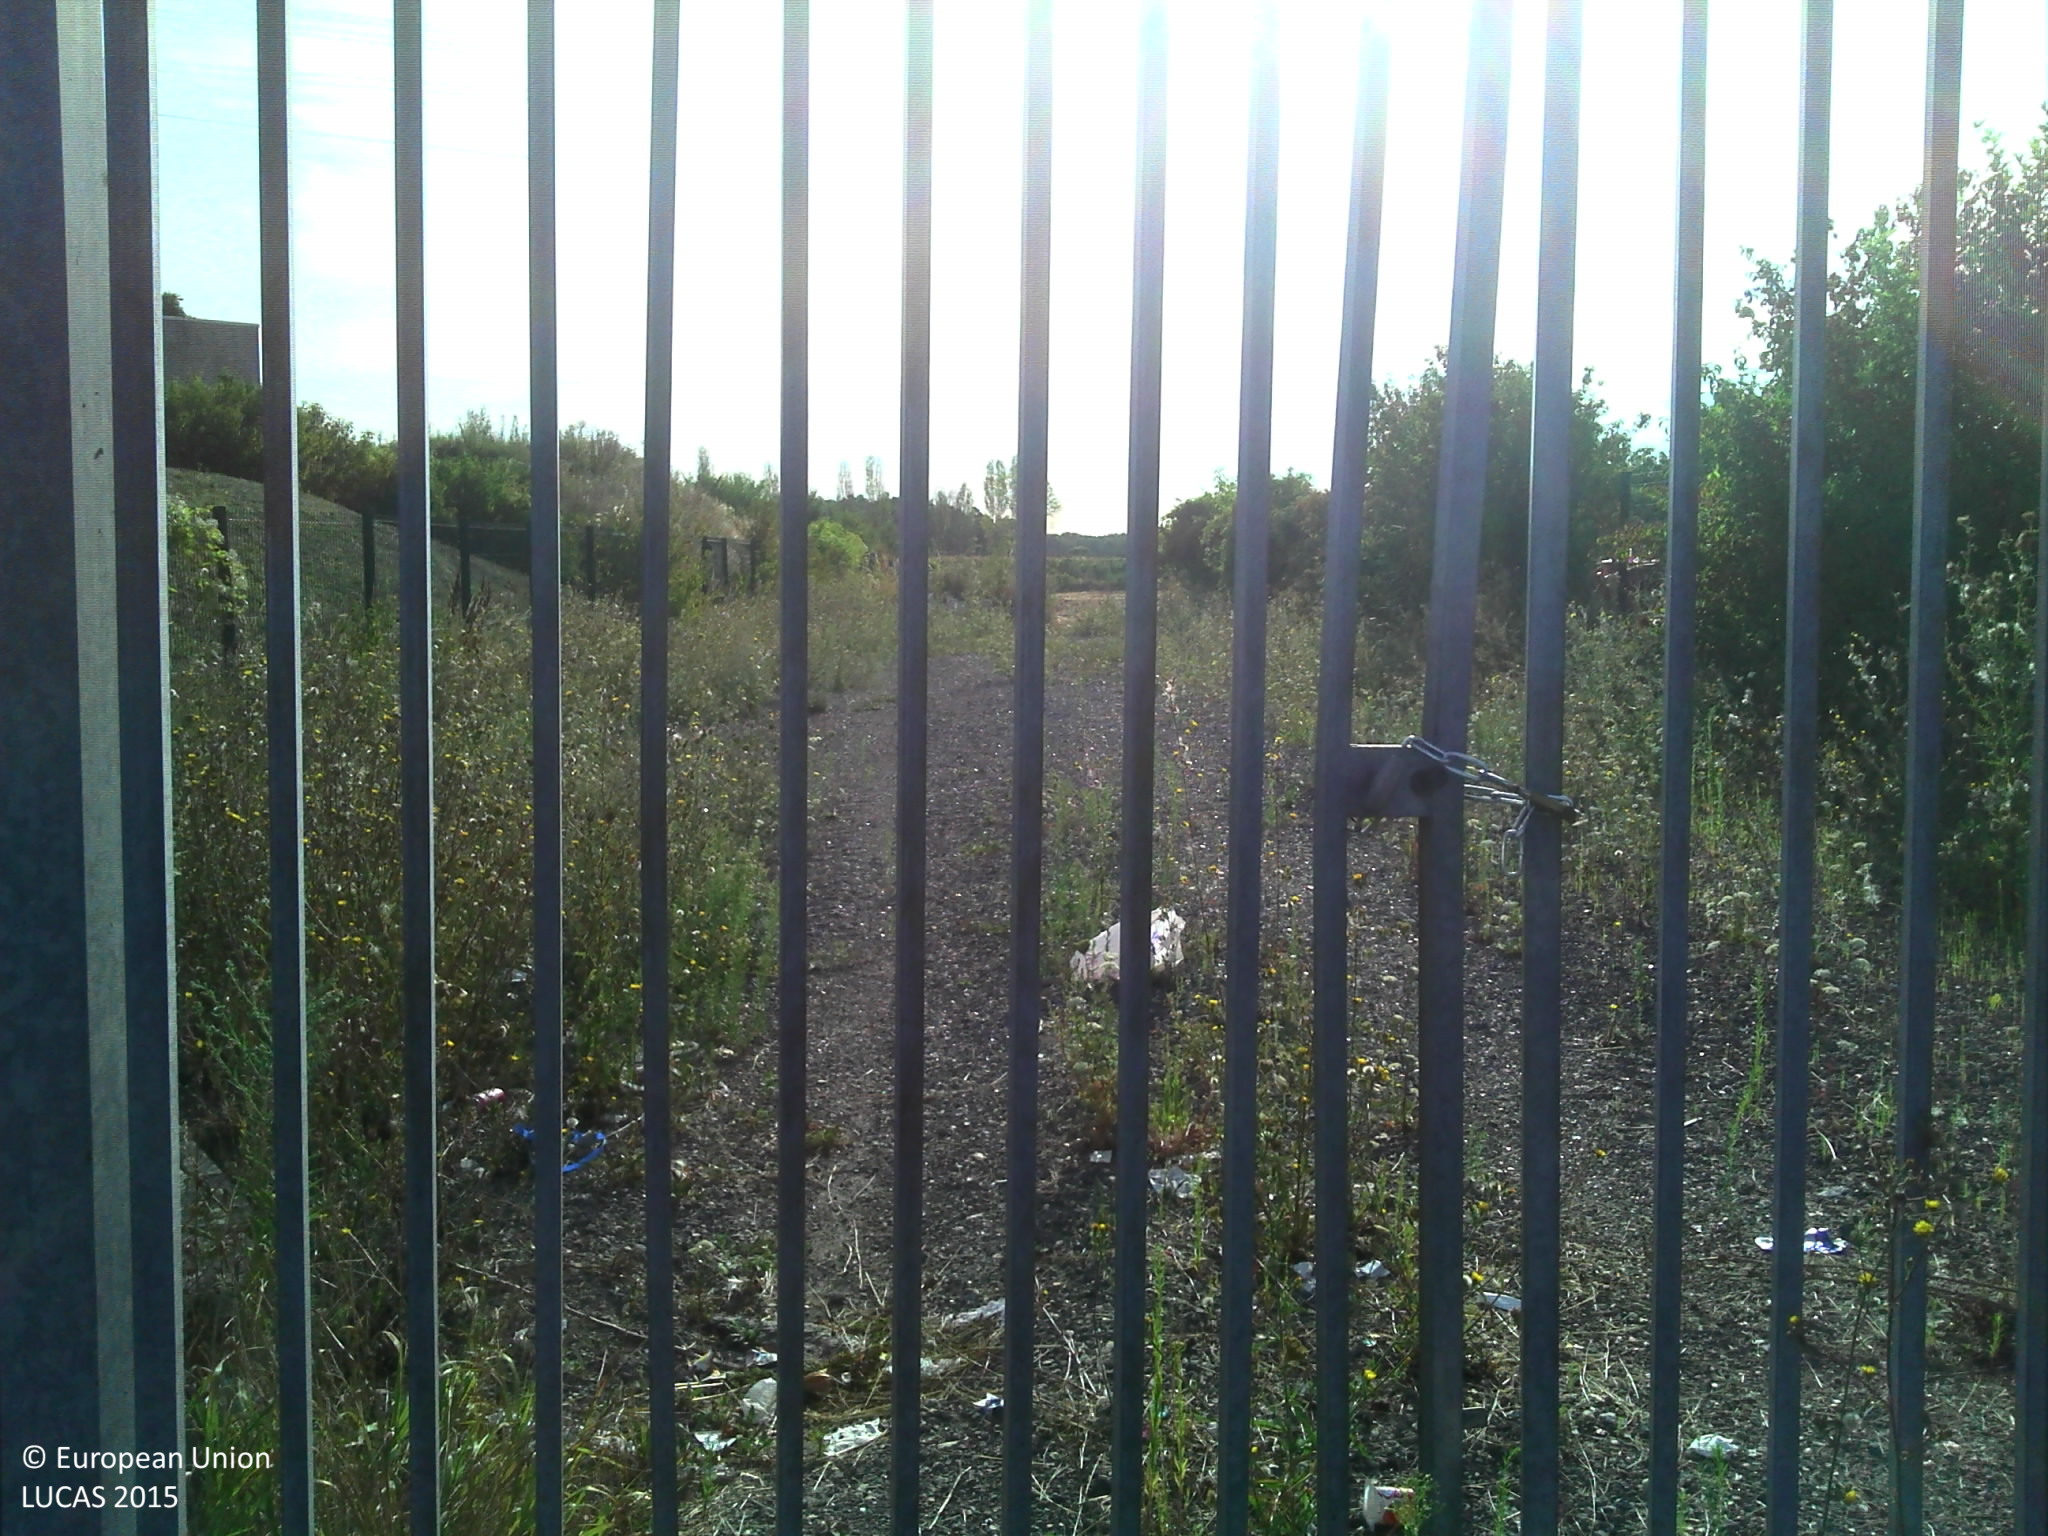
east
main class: Shrubland
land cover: Shrubland with sparse tree cover
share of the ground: > 75 %
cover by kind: shrubs 25 %, herbaceous plants 20 %, lichens and mosses 10 %, unconsolidated bare surface 10 %, broadleaved forest trees 5 %
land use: Abandoned areas
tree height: > 5 m
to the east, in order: Shrubland with sparse tree cover; Grassland without tree/shrub cover; Tracks; Lines of trees; Common wheat; Single bushes/trees; Grass margins; Artificial constructions in urban areas; Single bushes/trees; Tracks; Grass margins; Common wheat
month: August
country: FR
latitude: 48.9522
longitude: 2.6289
